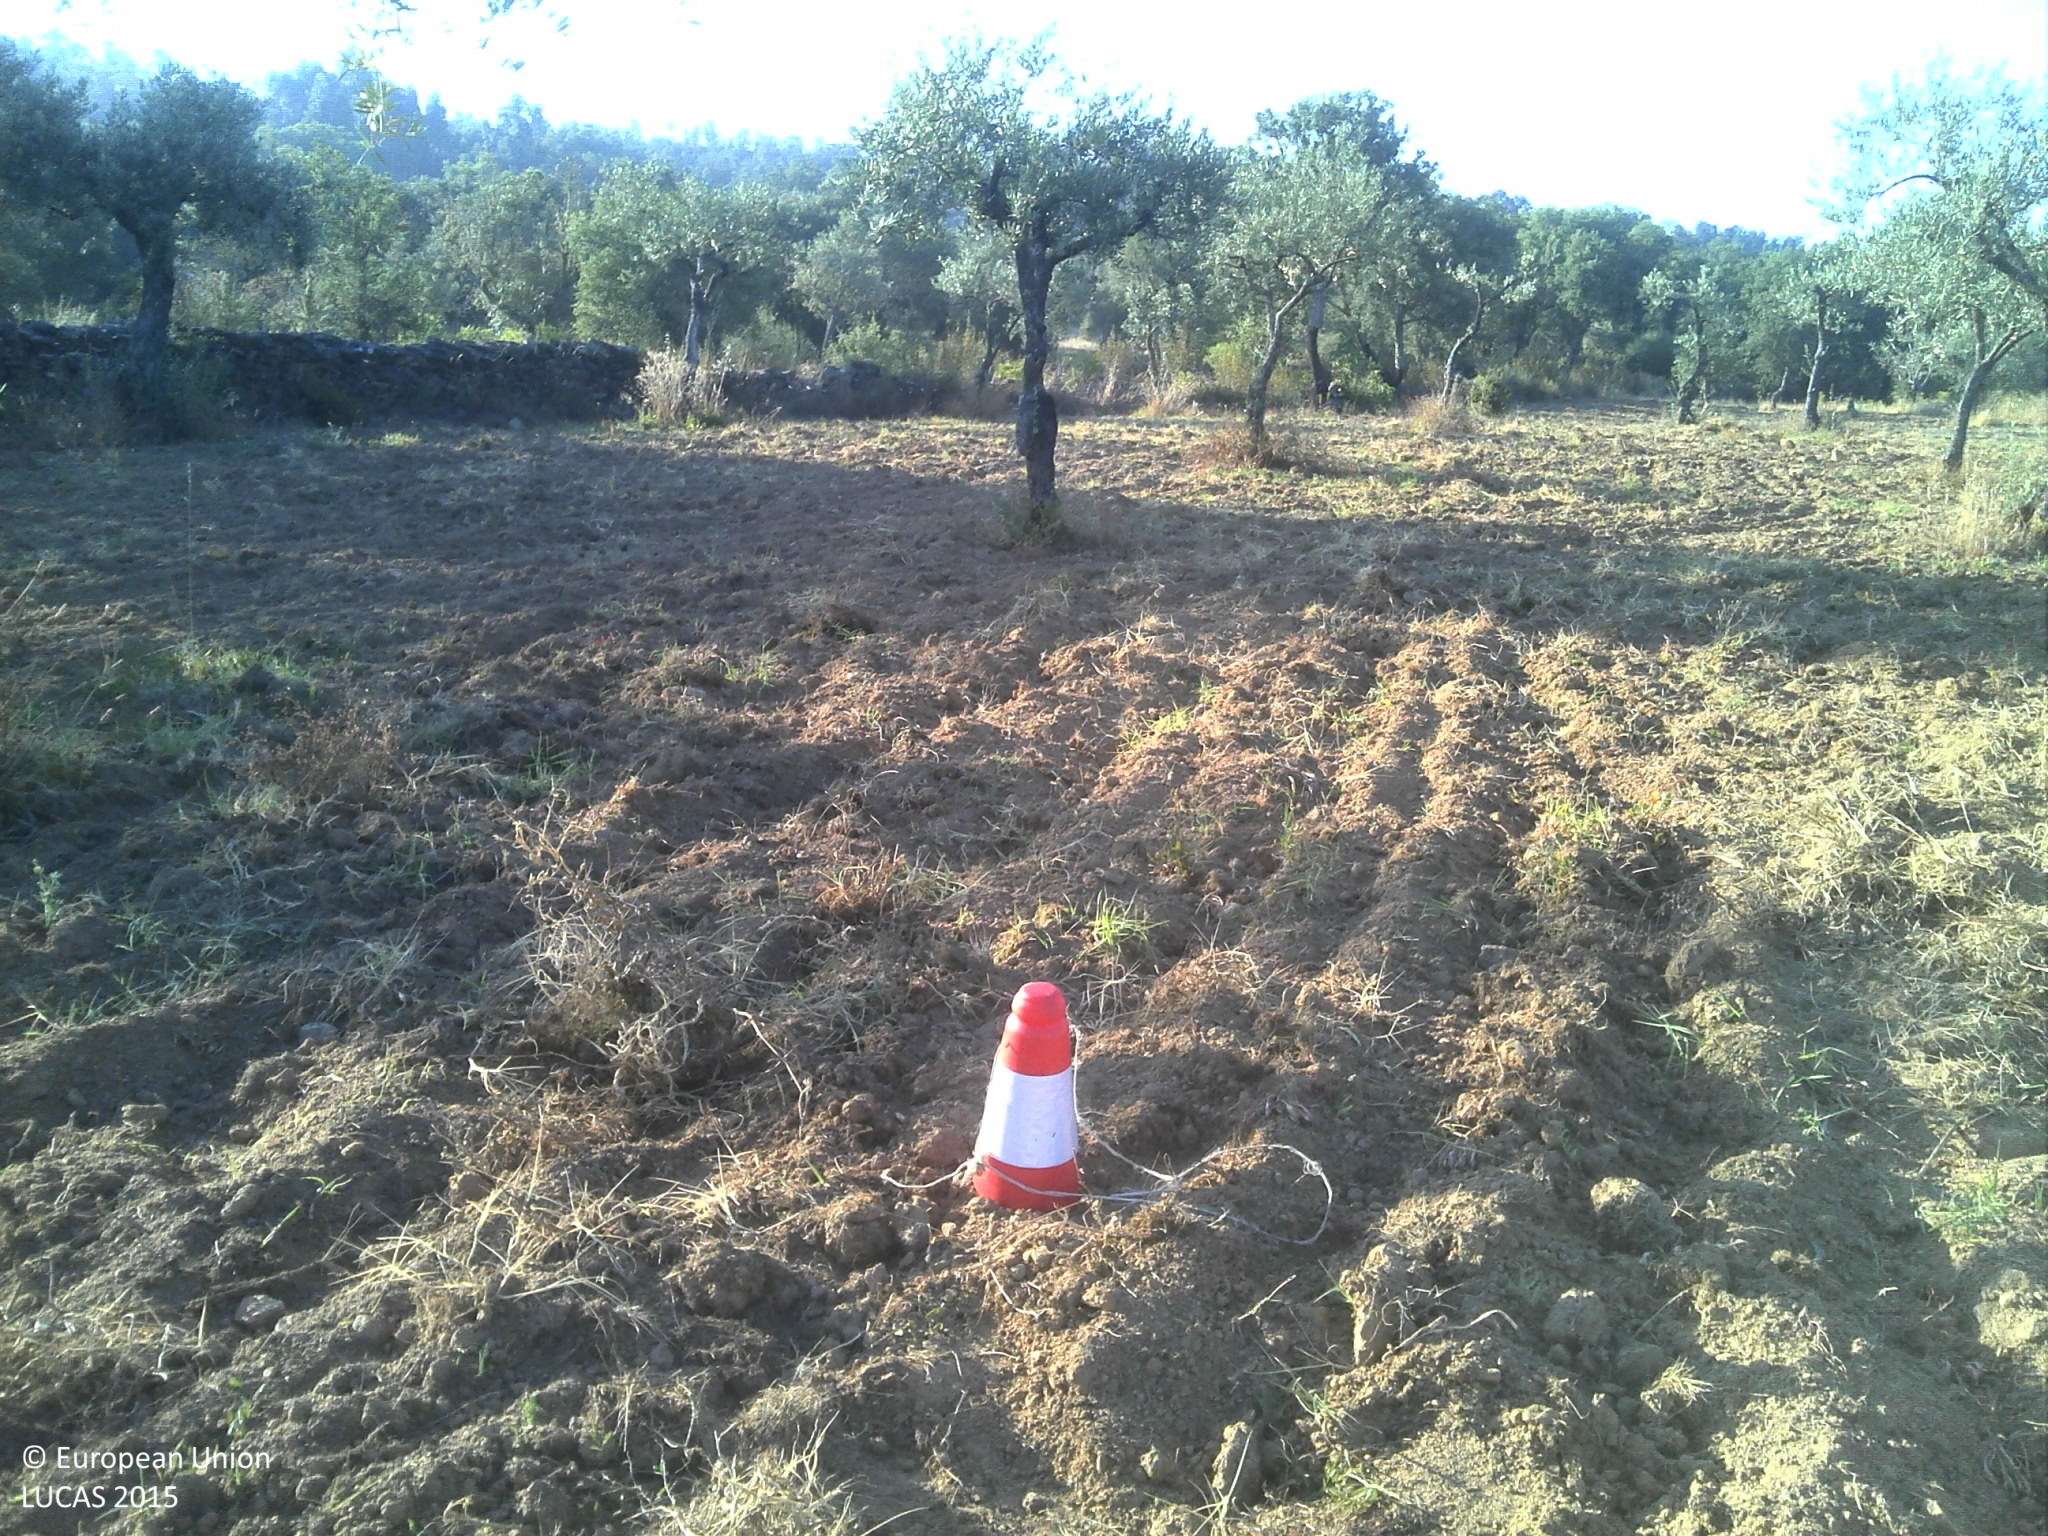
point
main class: Cropland
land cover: Olive groves
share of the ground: 25 - 50 %
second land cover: Other bare soil
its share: > 75 %
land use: Agriculture (excluding fallow land and kitchen gardens)
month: June
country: PT
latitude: 39.9229
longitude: -7.5710
